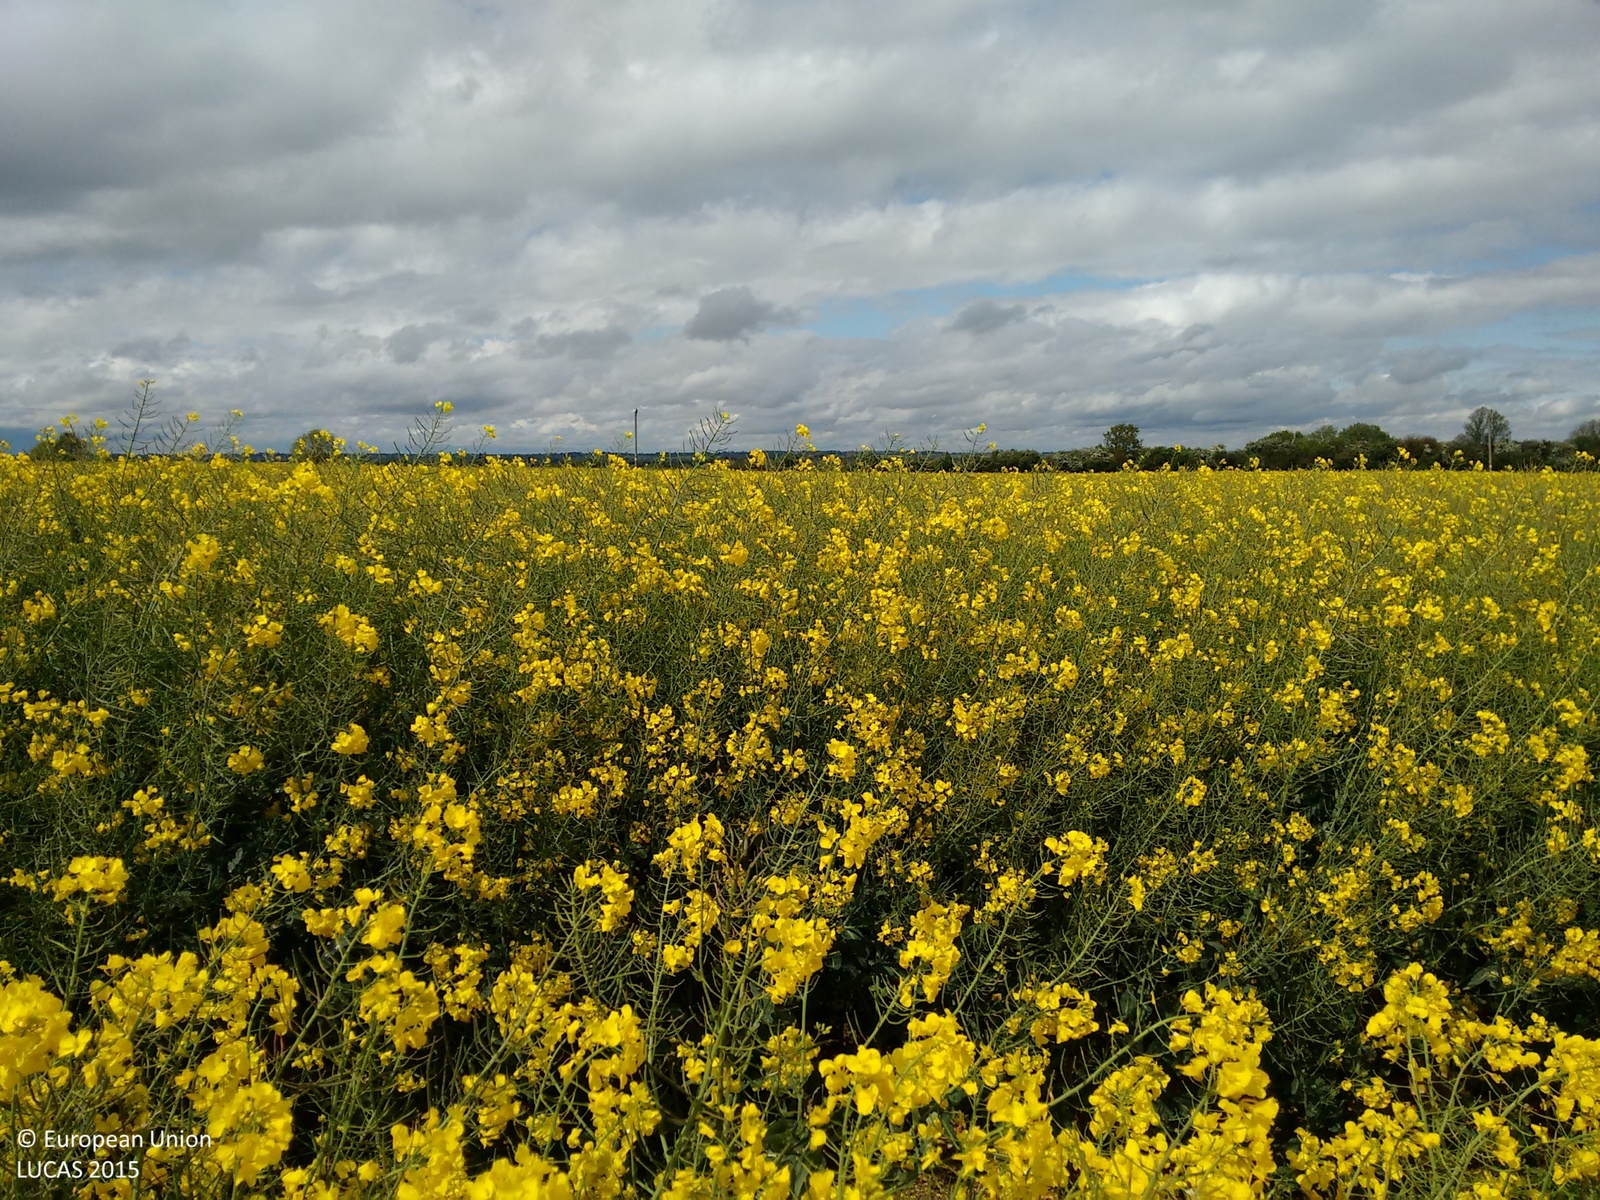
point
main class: Cropland
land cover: Rape and turnip rape
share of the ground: > 75 %
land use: Agriculture (excluding fallow land and kitchen gardens)
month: May
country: GB
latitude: 52.2756
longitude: -1.2597
